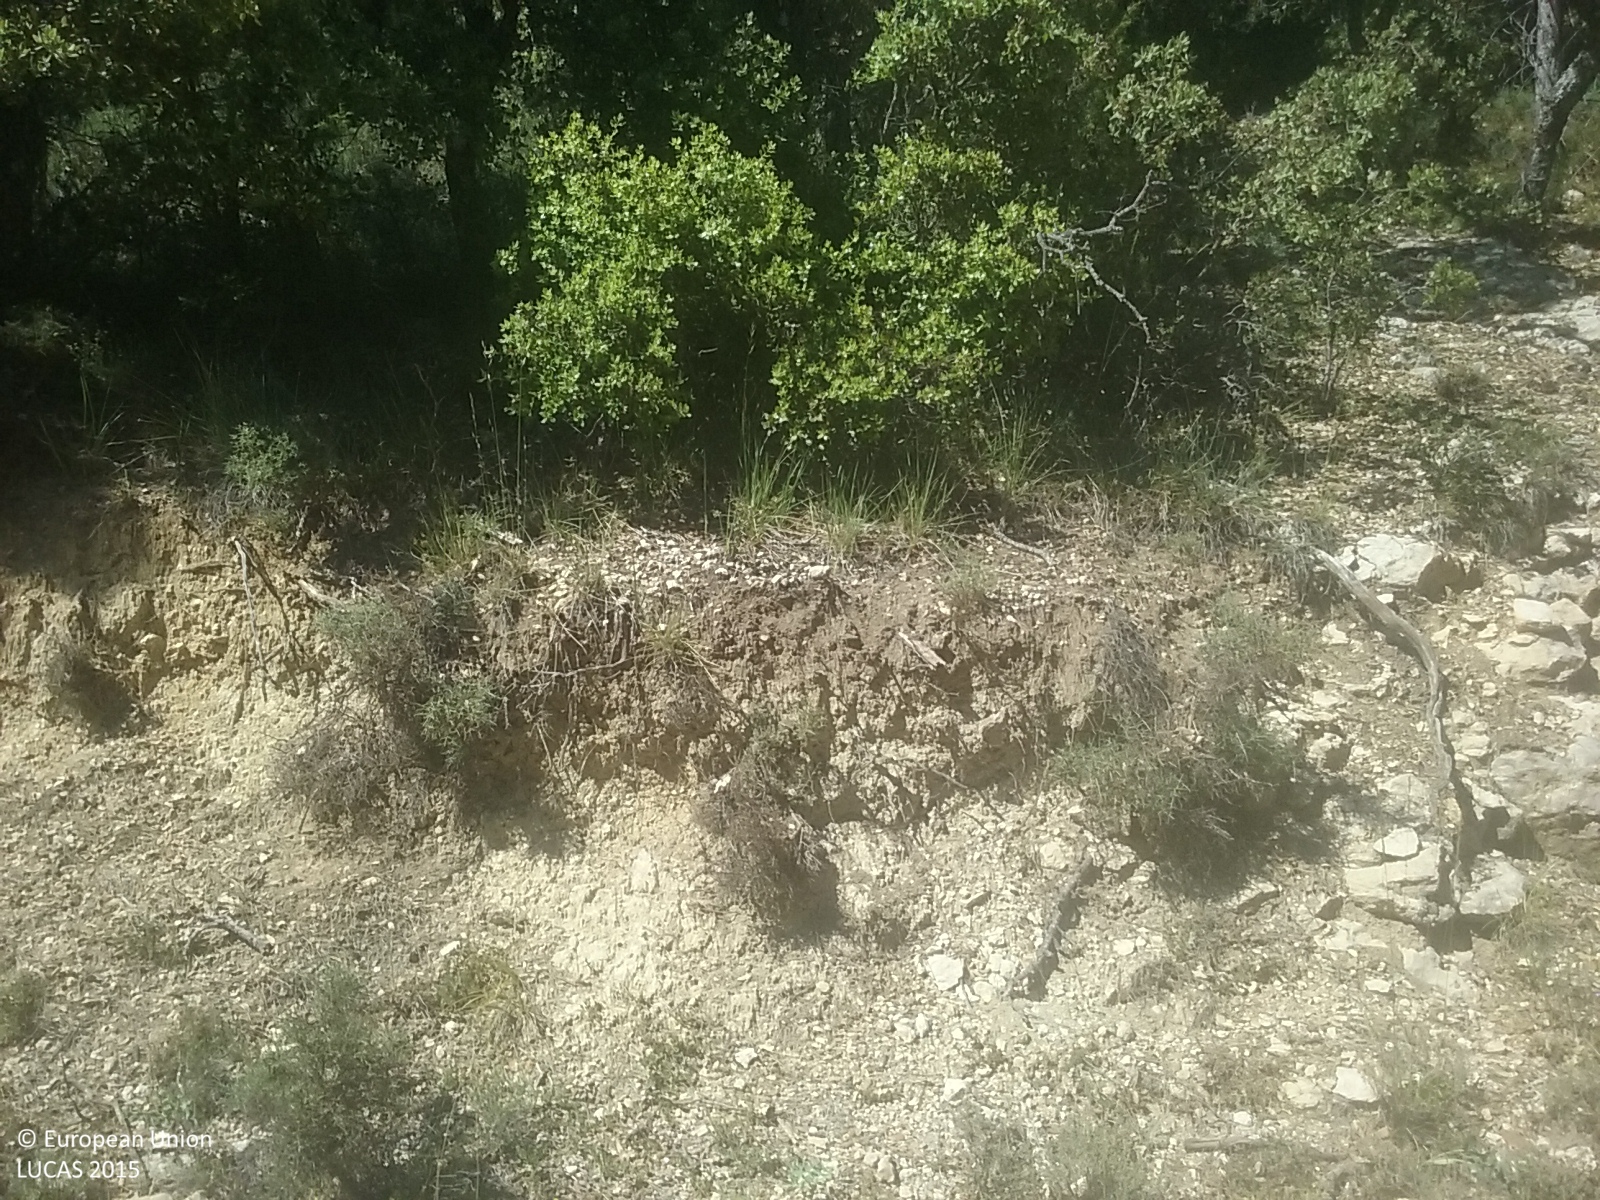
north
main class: Woodland
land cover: Pine dominated mixed woodland
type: coniferous forest of the mediterranean region
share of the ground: > 75 %
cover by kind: coniferous forest trees 40 %, broadleaved forest trees 40 %, shrubs 10 %, unconsolidated bare surface 10 %
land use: Forestry
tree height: > 5 m
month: June
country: ES
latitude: 40.6453
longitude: -0.0232
